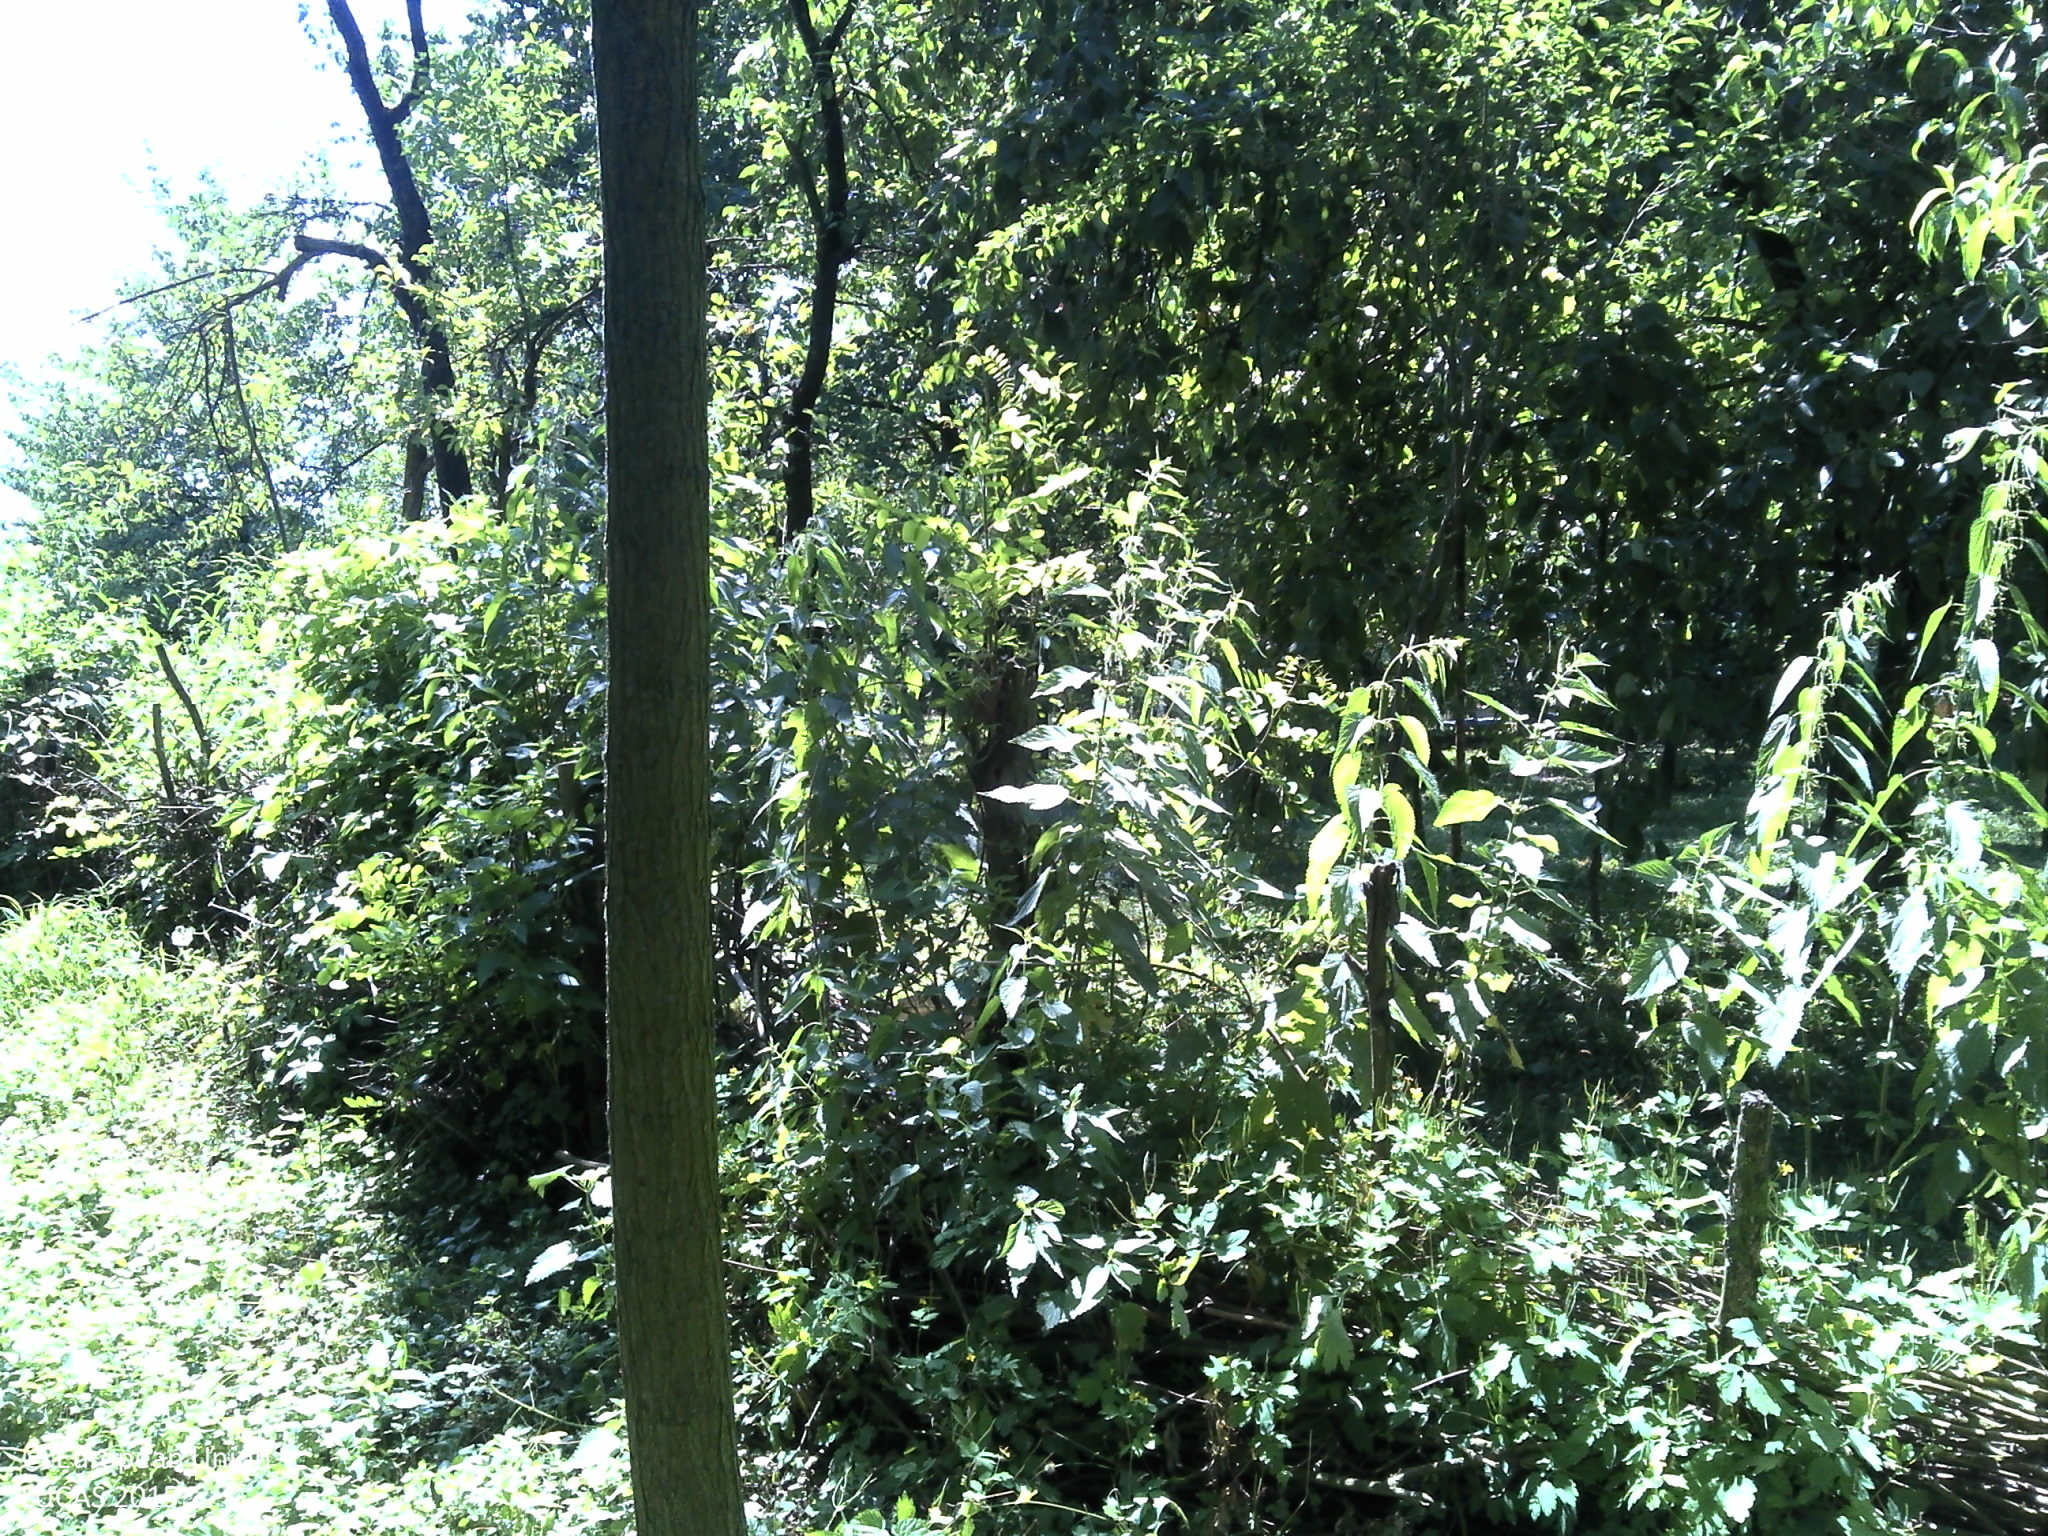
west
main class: Grassland
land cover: Grassland with sparse tree/shrub cover
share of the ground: > 75 %
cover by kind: herbaceous plants 95 %, broadleaved forest trees 5 %
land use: Semi-natural and natural areas not in use
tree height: < 5 m
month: June
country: HR
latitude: 45.7429
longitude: 18.2447
